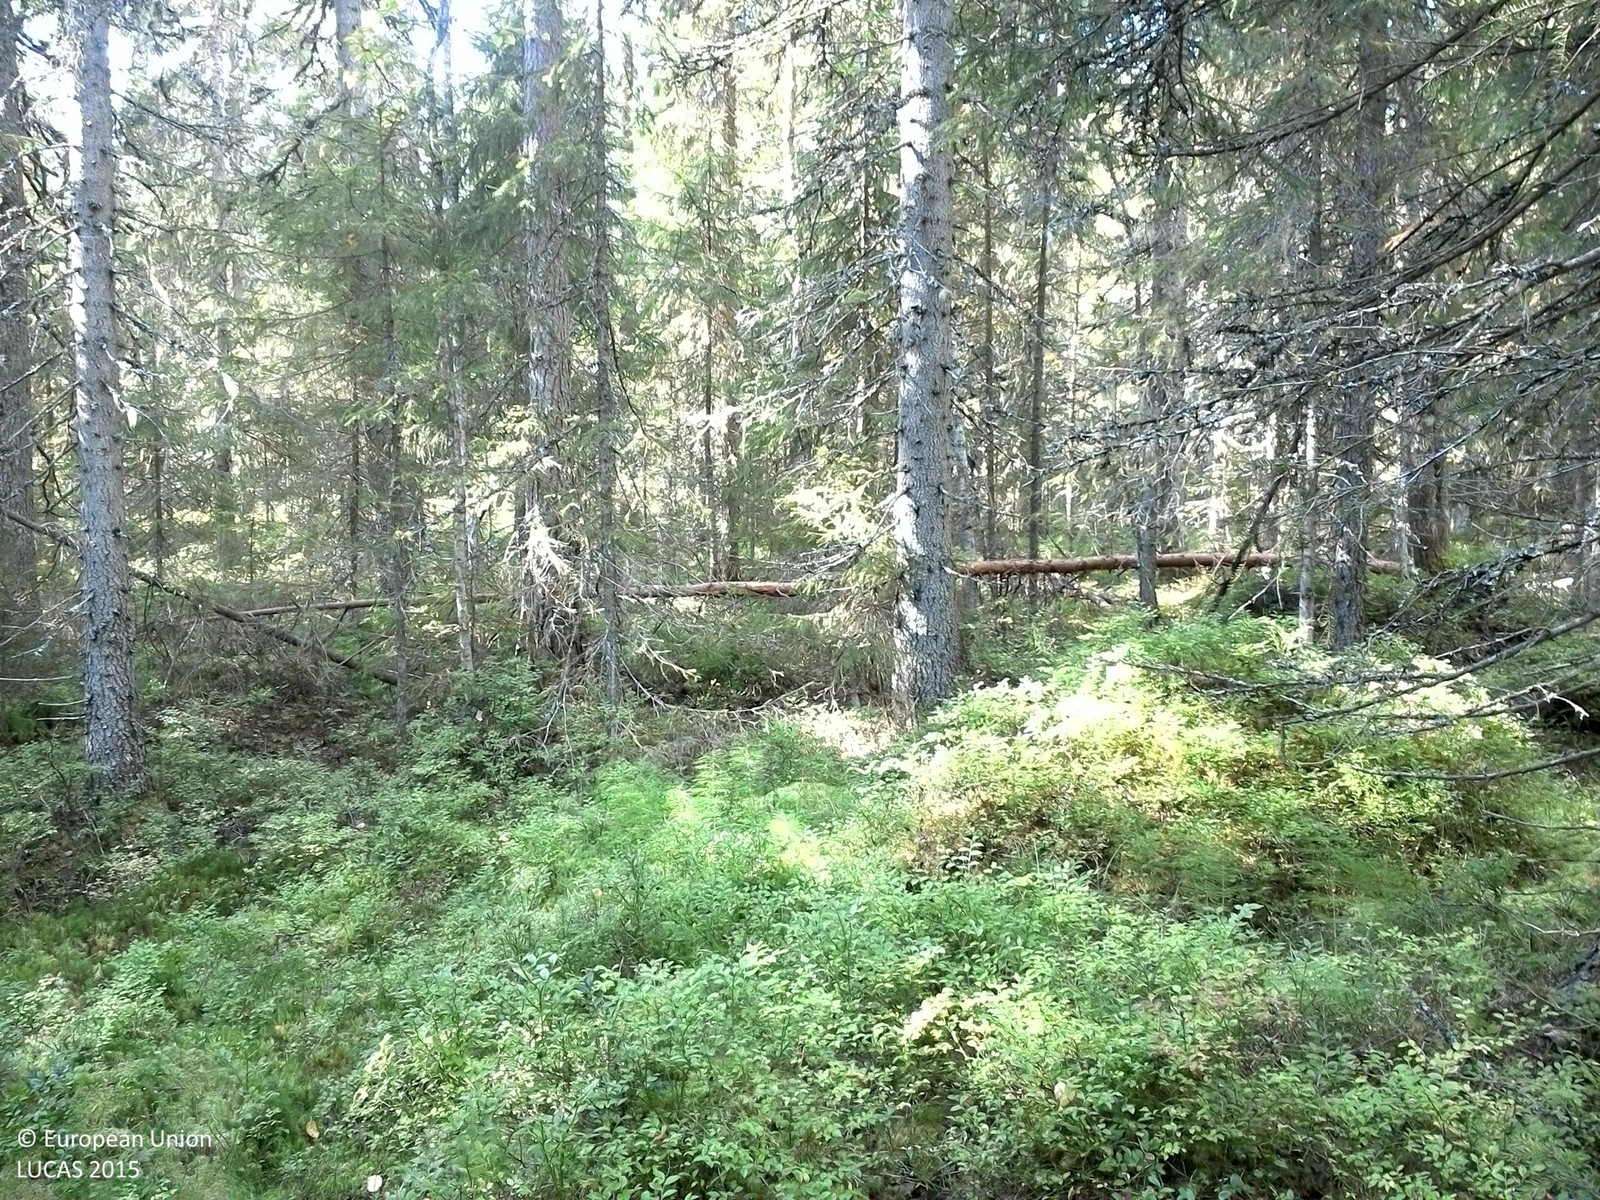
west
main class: Woodland
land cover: Spruce dominated coniferous woodland
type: boreal forest
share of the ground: 50 - 75 %
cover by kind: coniferous forest trees 60 %, shrubs 20 %, lichens and mosses 15 %, broadleaved forest trees 5 %
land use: Forestry
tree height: > 5 m
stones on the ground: 25 - 50 %
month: September
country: SE
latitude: 63.8824
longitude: 16.5479
